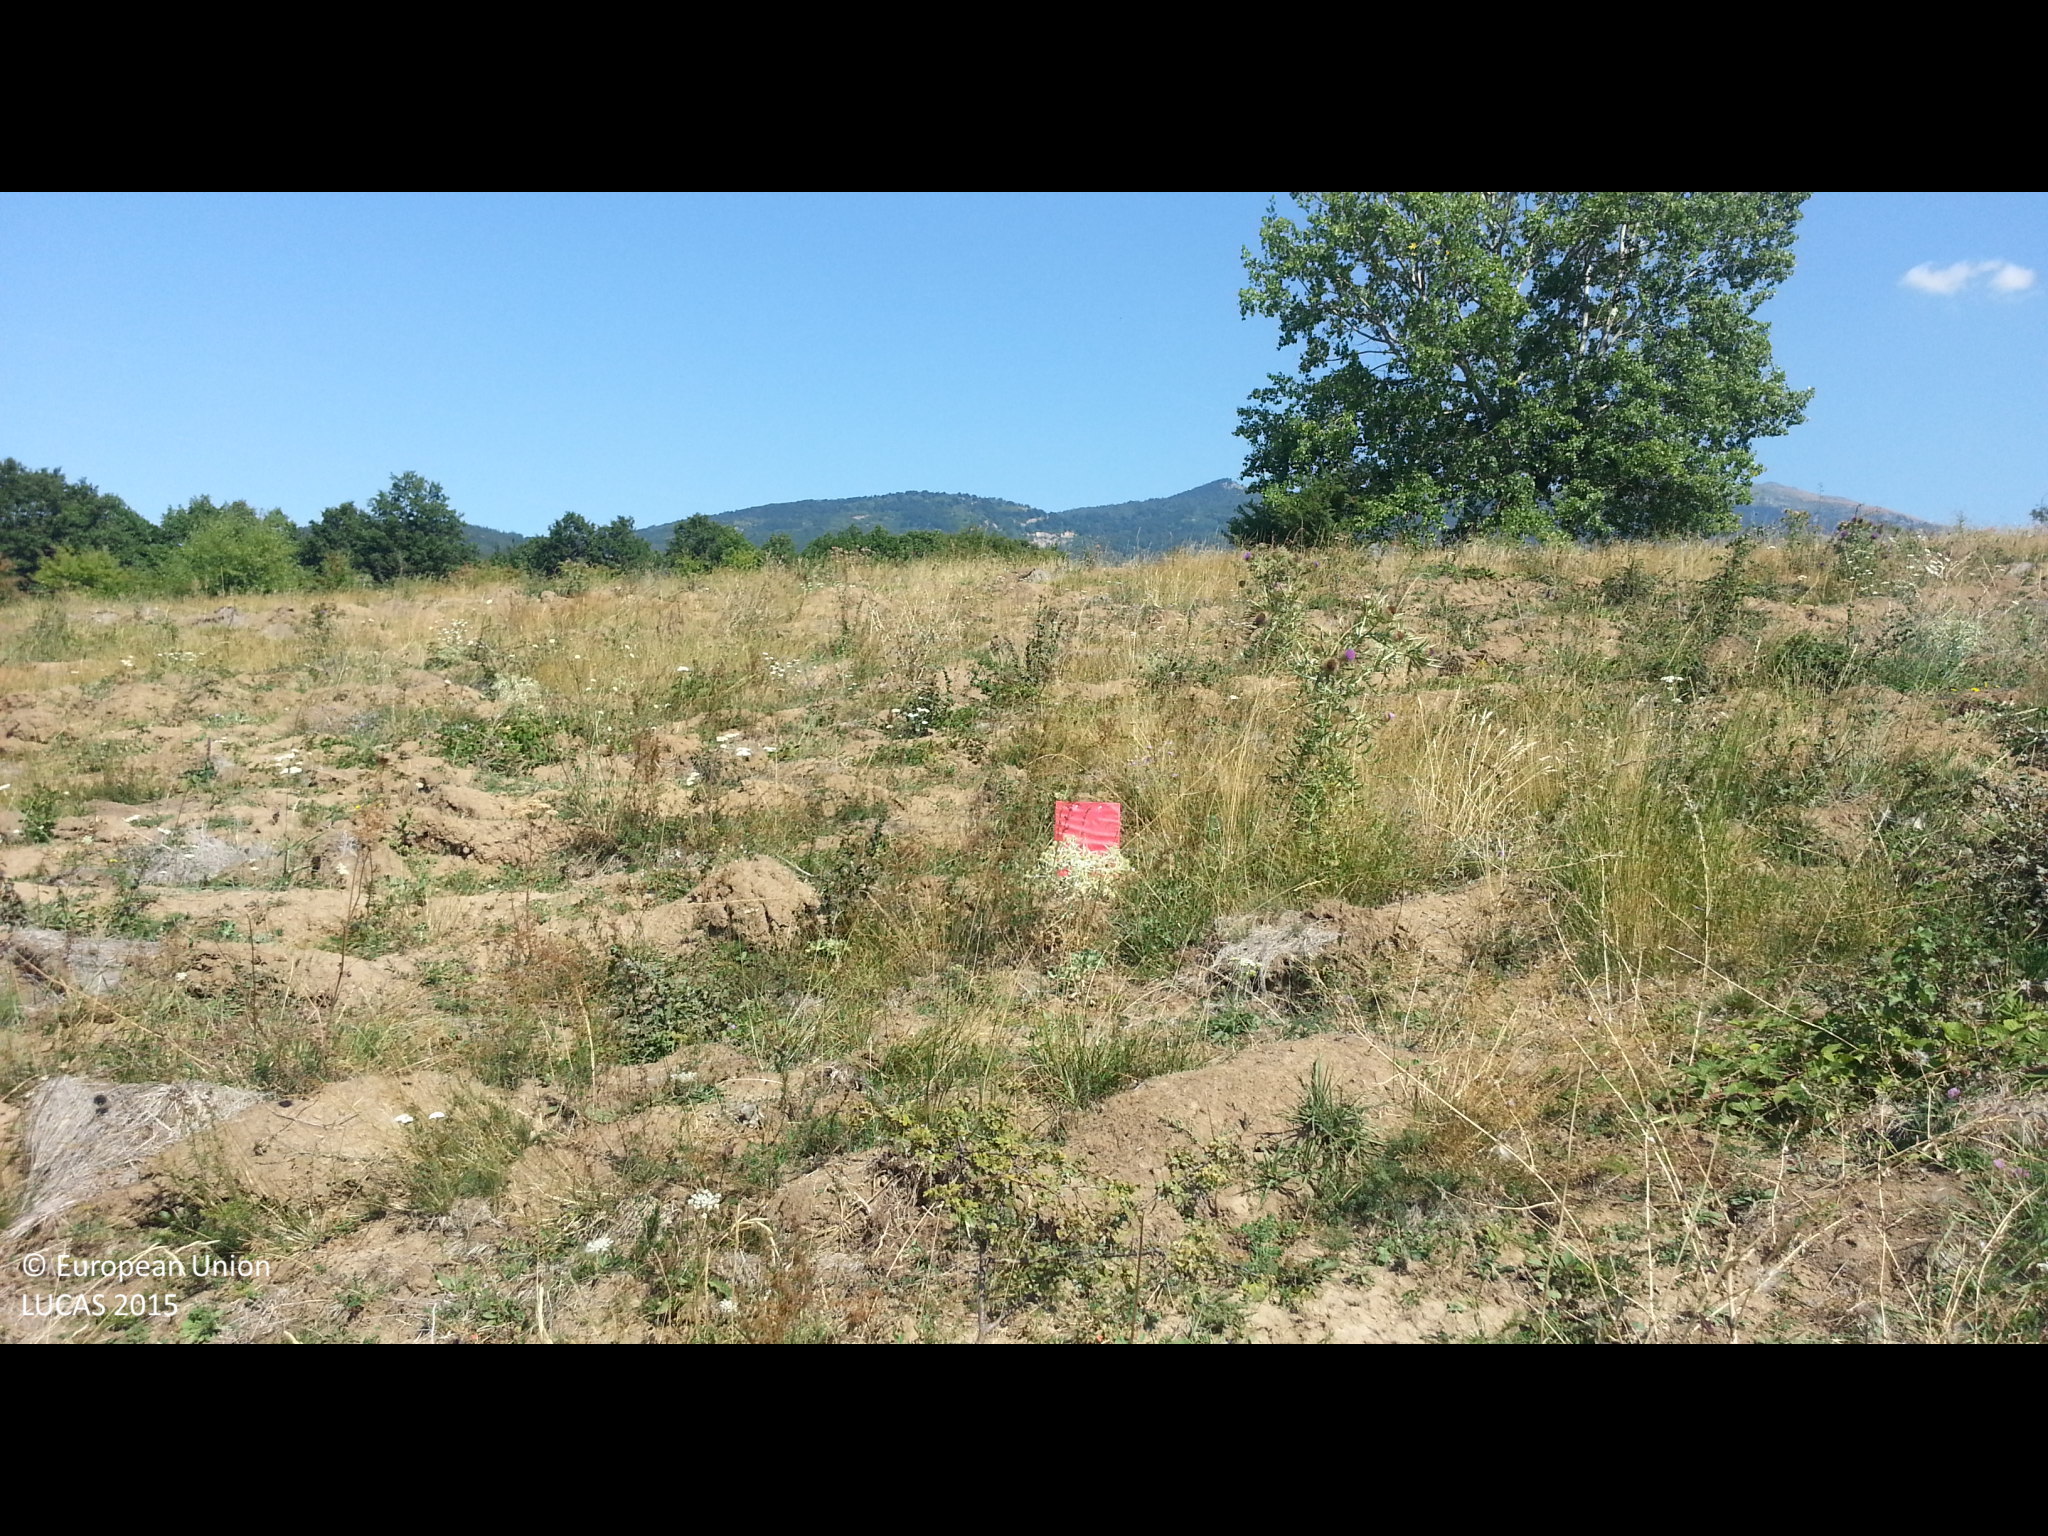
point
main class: Grassland
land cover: Spontaneously vegetated surfaces
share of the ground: 50 - 75 %
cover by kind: herbaceous plants 70 %, unconsolidated bare surface 30 %
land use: Fallow land
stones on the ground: < 10 %
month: August
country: BG
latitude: 42.5779
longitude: 23.1525
